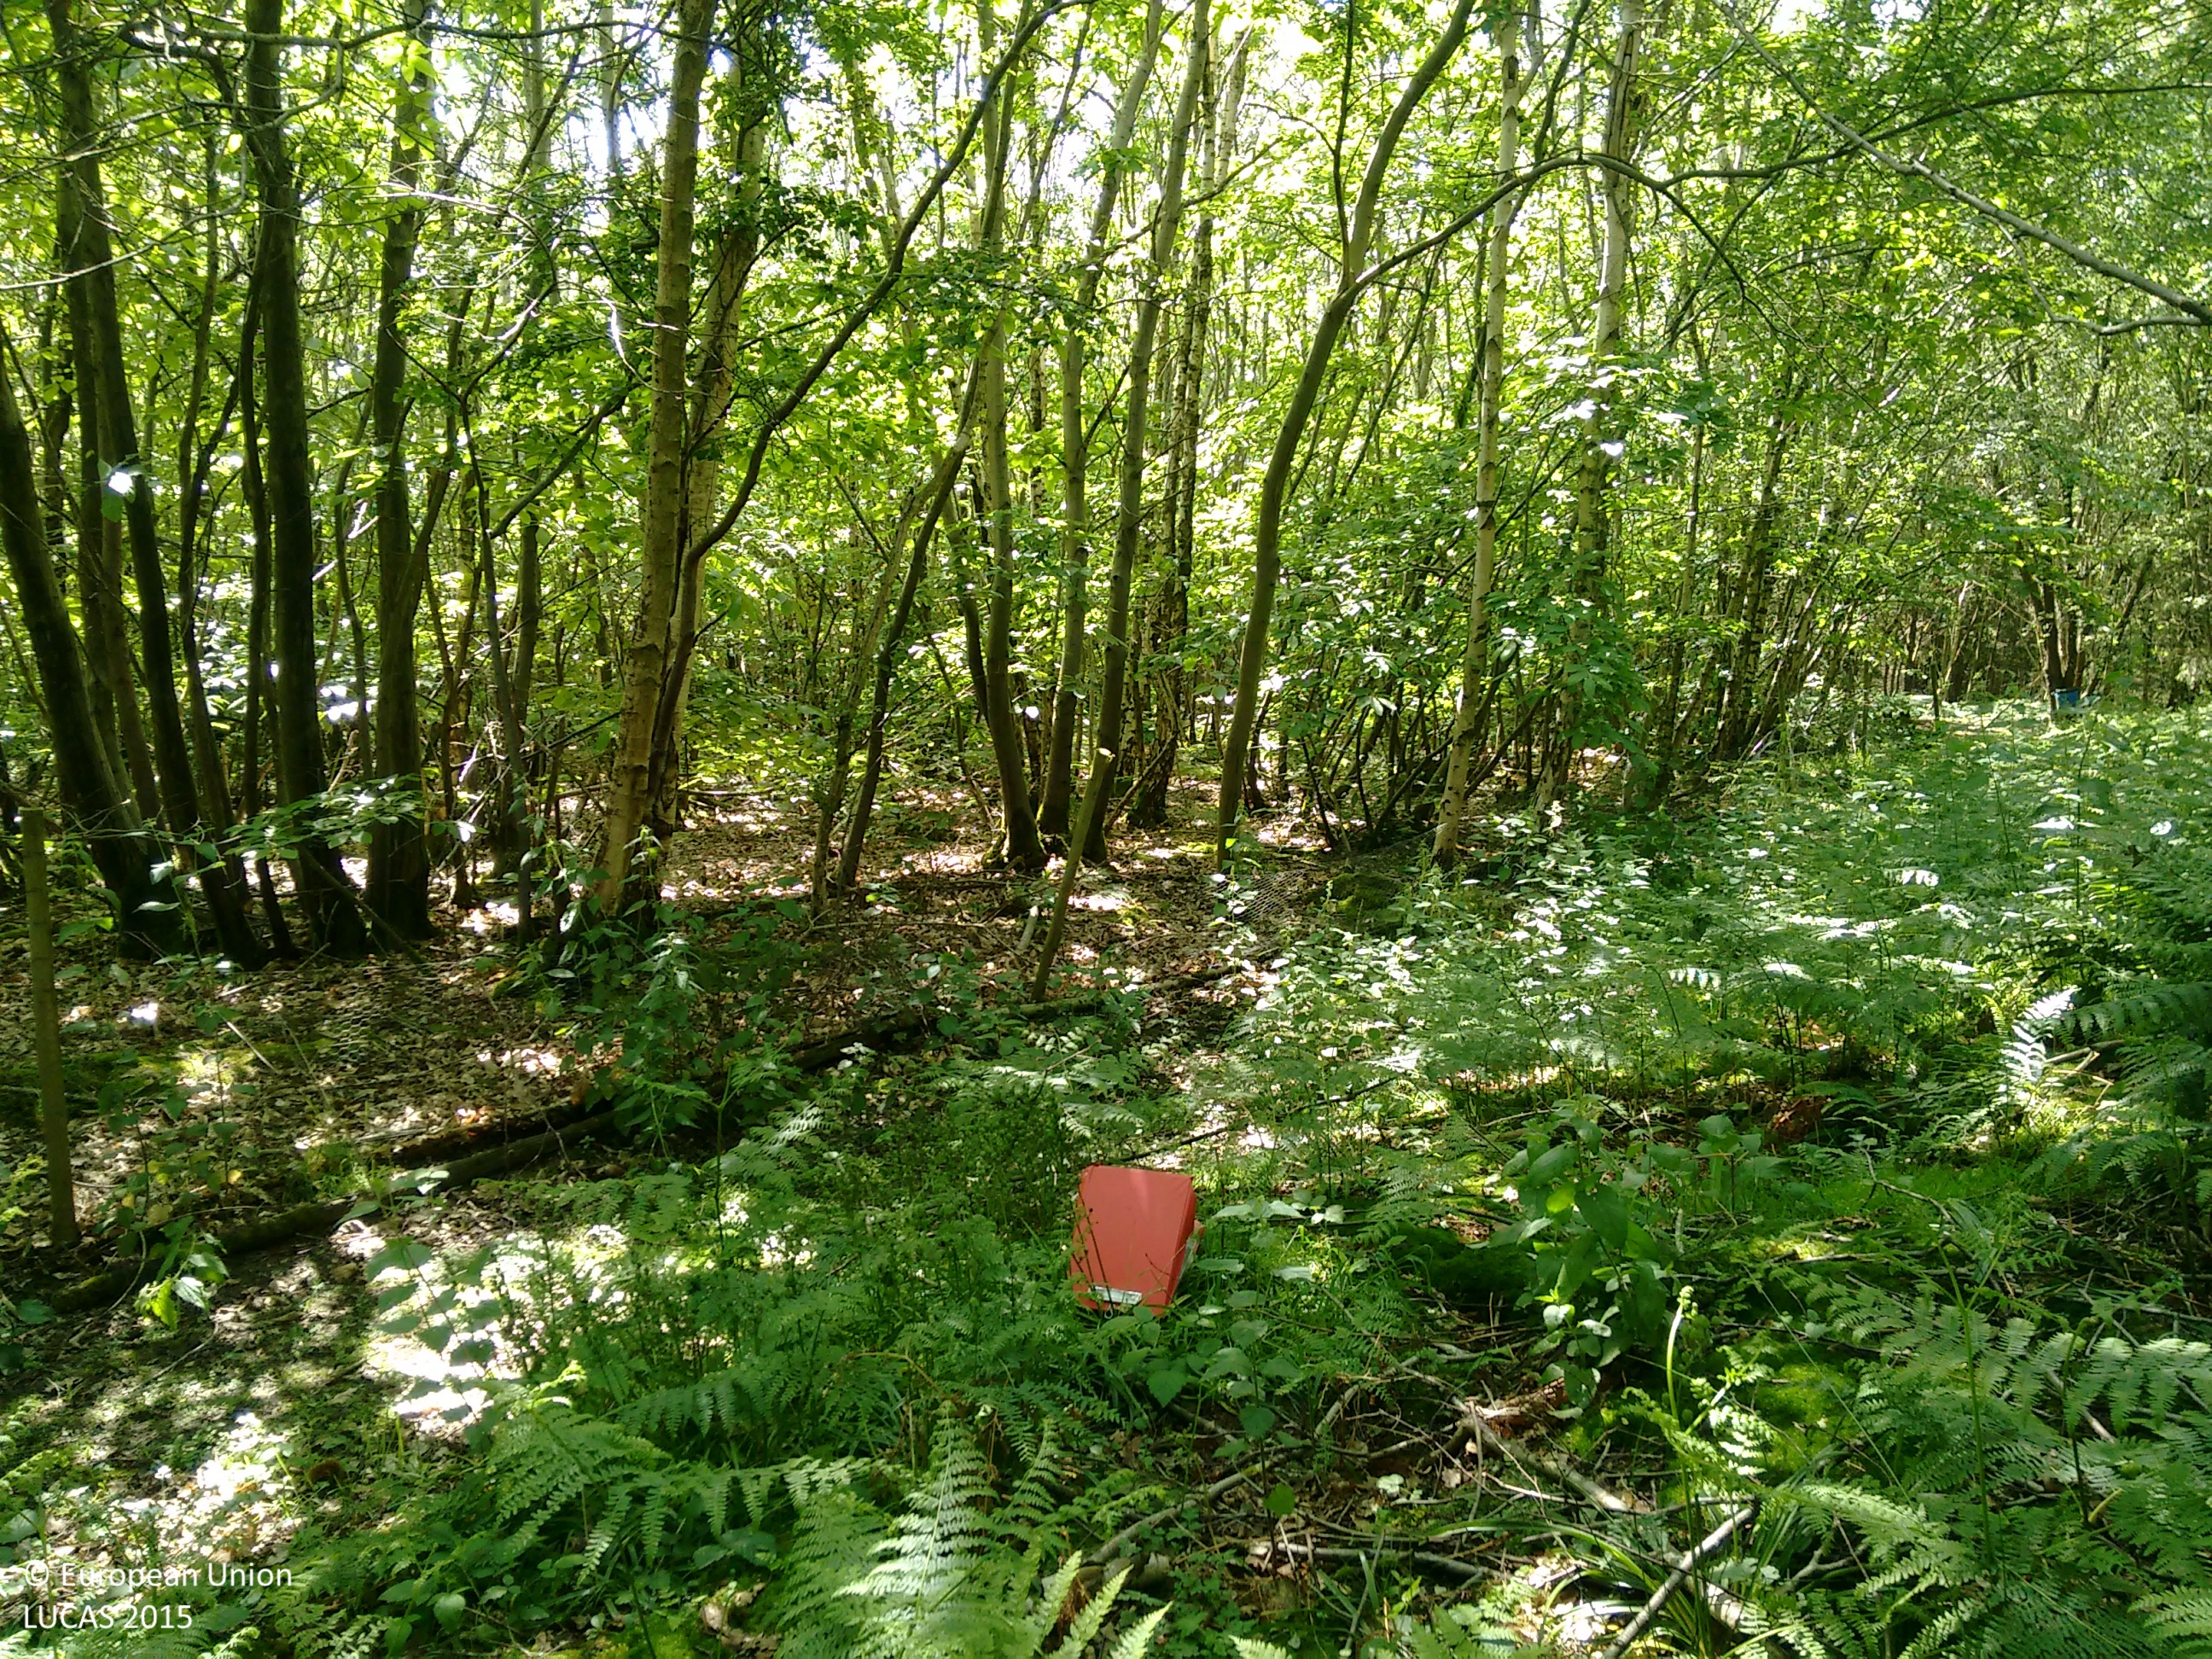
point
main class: Woodland
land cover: Broadleaved woodland
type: mesophytic deciduous forest
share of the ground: > 75 %
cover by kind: broadleaved forest trees 75 %, coniferous forest trees 15 %, shrubs 5 %, herbaceous plants 5 %
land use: Forestry
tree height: > 5 m
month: June
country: GB
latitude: 51.0445
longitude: 0.6021
